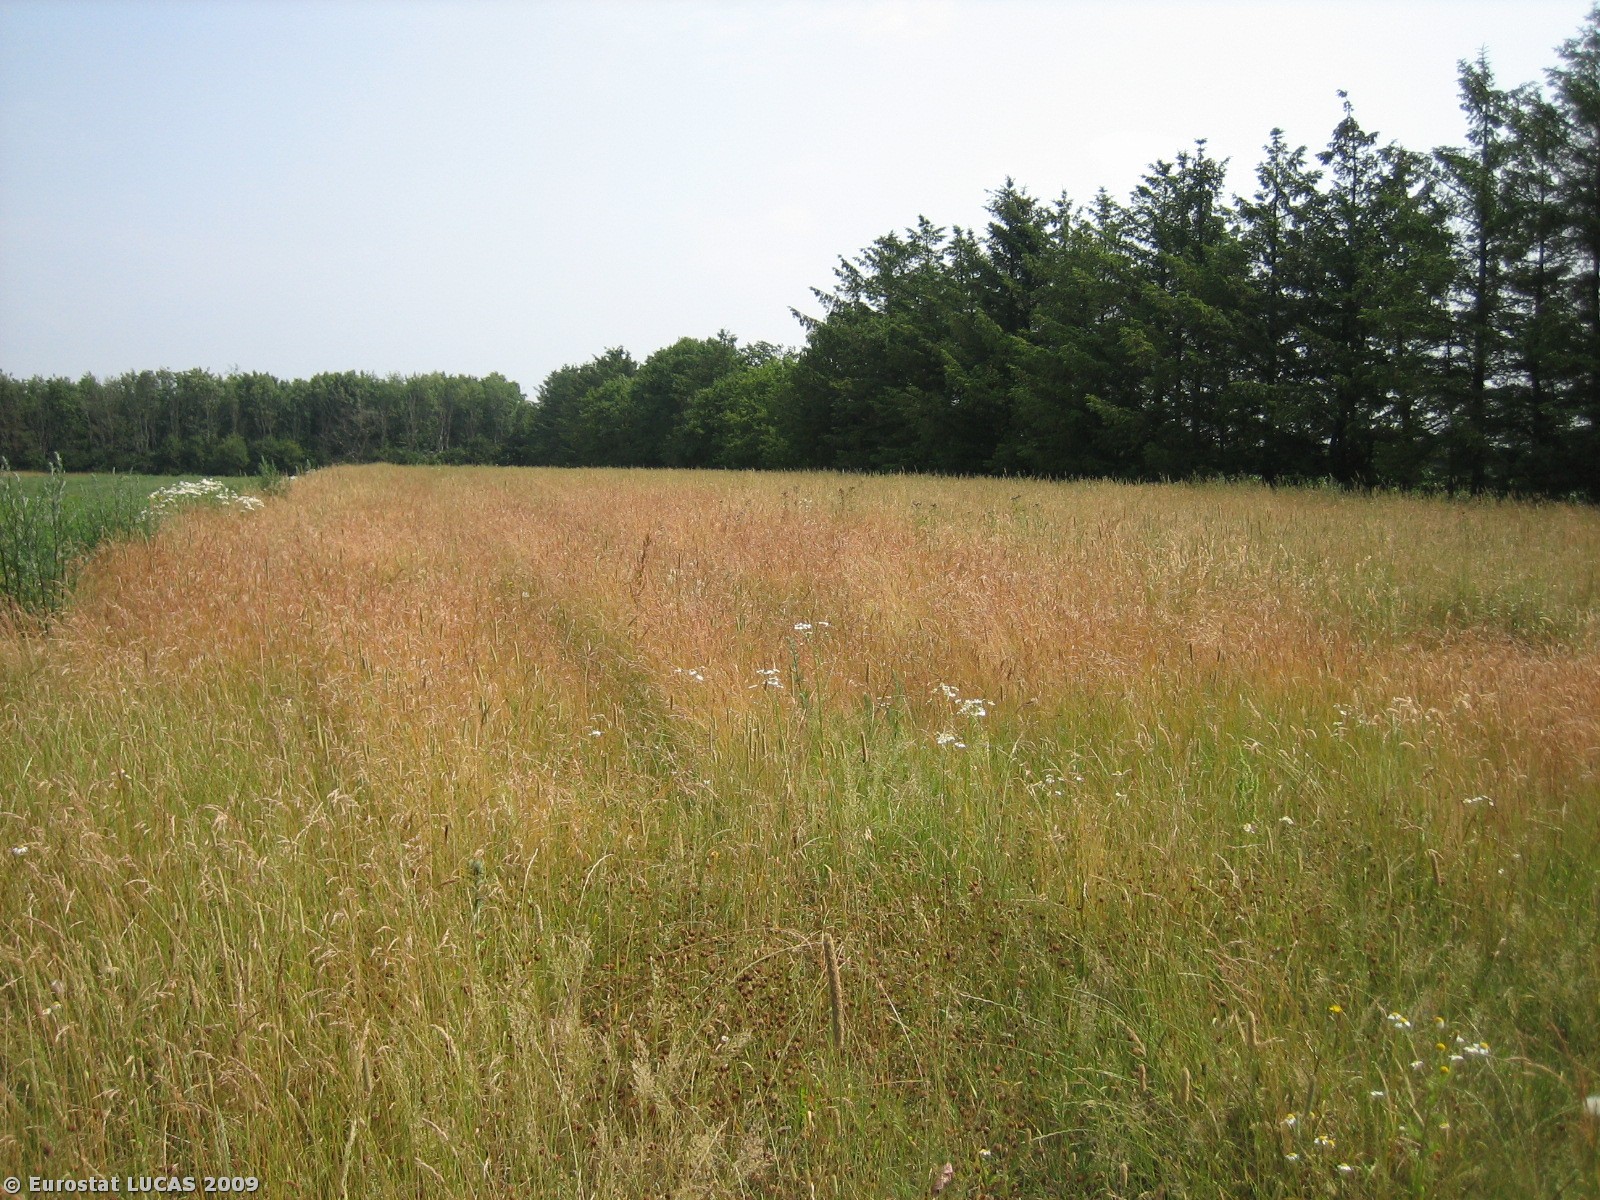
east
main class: Grassland
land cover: Grassland without tree/shrub cover
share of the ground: > 75 %
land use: Agriculture (excluding fallow land and kitchen gardens)
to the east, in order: Grassland without tree/shrub cover; Coniferous woodland; Grass margins; Grassland without tree/shrub cover
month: July
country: DK
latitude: 55.4985
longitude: 8.7506
